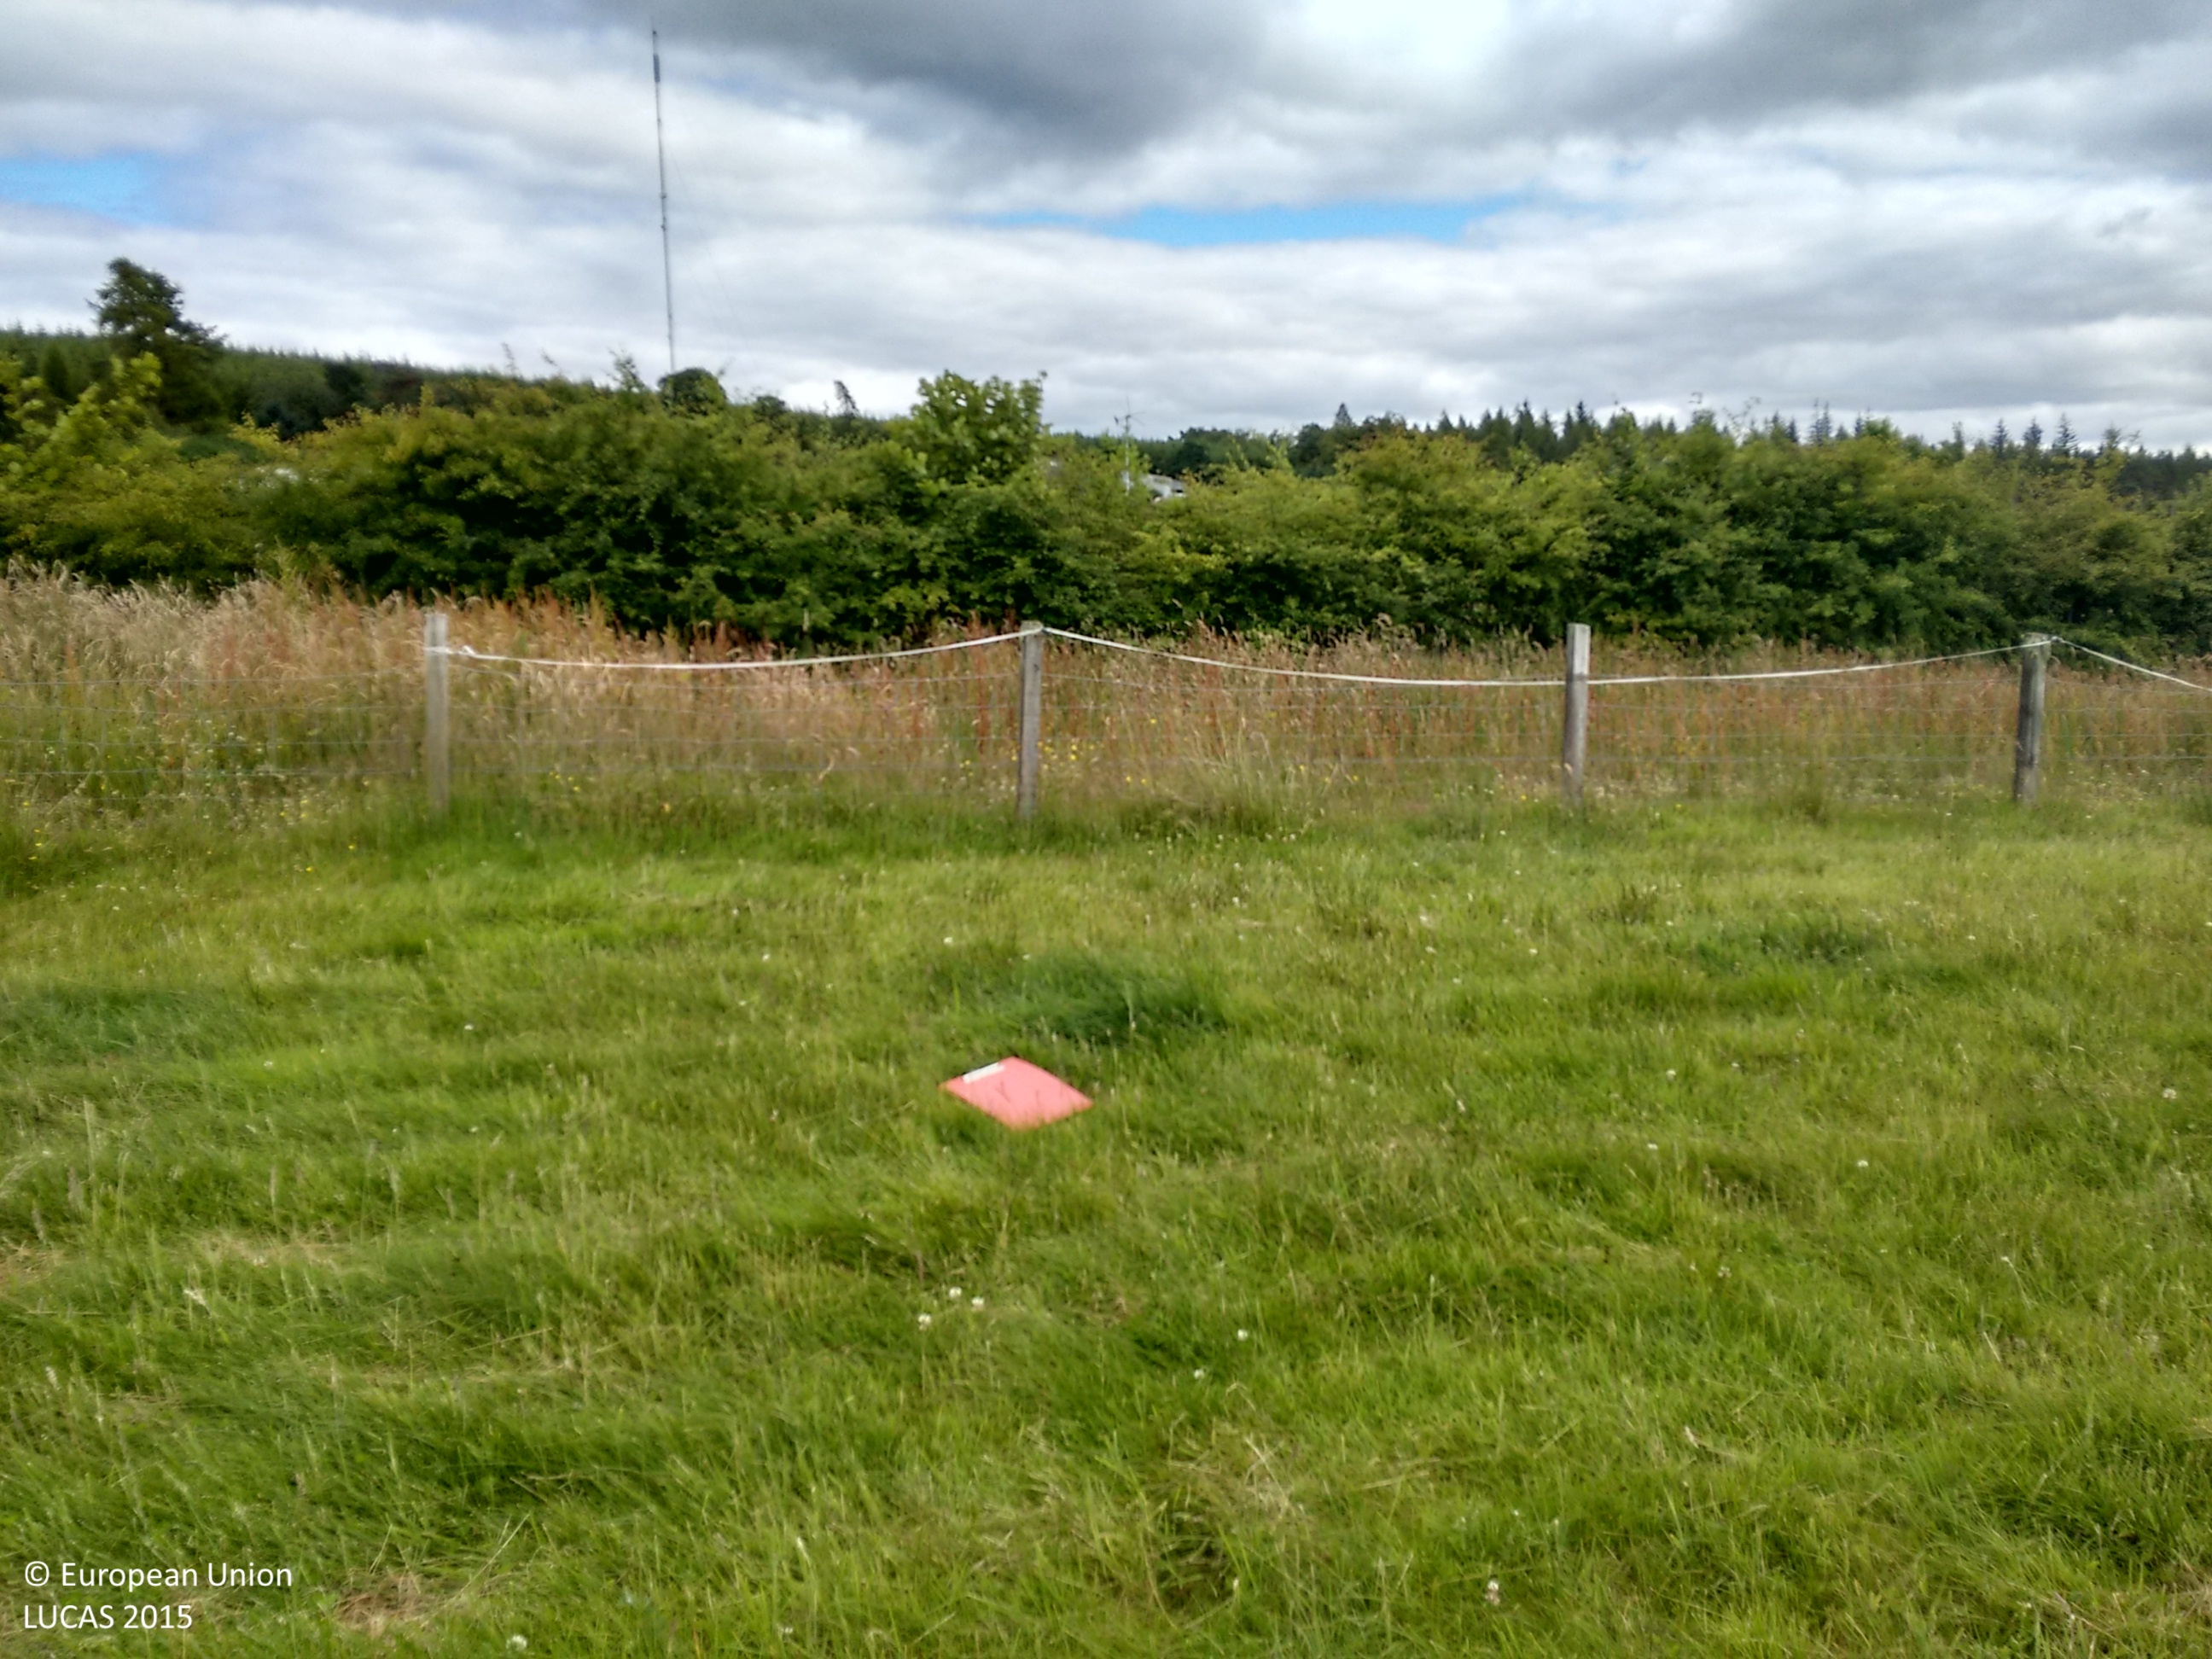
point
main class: Grassland
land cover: Grassland without tree/shrub cover
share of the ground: > 75 %
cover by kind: herbaceous plants 100 %
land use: Agriculture (excluding fallow land and kitchen gardens)
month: August
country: GB
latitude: 57.5966
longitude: -4.2909
